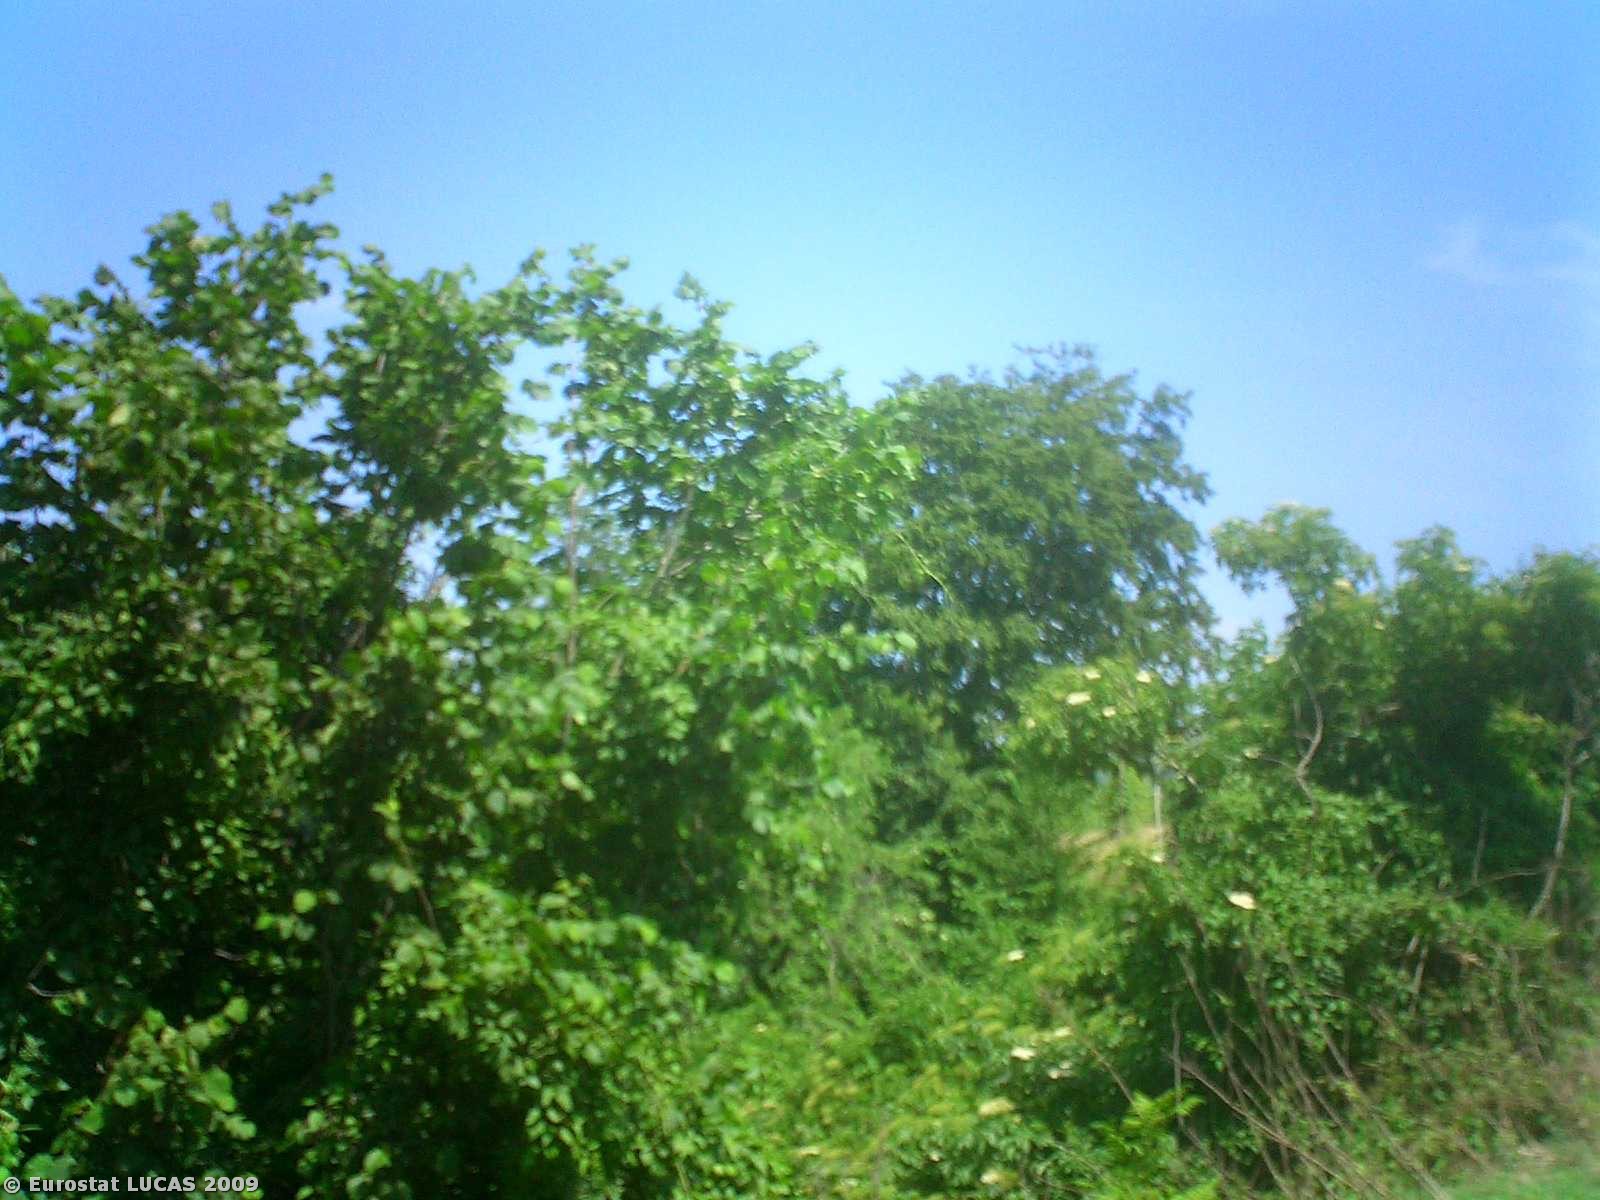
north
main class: Woodland
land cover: Mixed woodland
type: mesophytic deciduous forest
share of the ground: 50 - 75 %
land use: Forestry
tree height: > 5 m
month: May
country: IT
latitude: 44.2294
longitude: 11.6362
